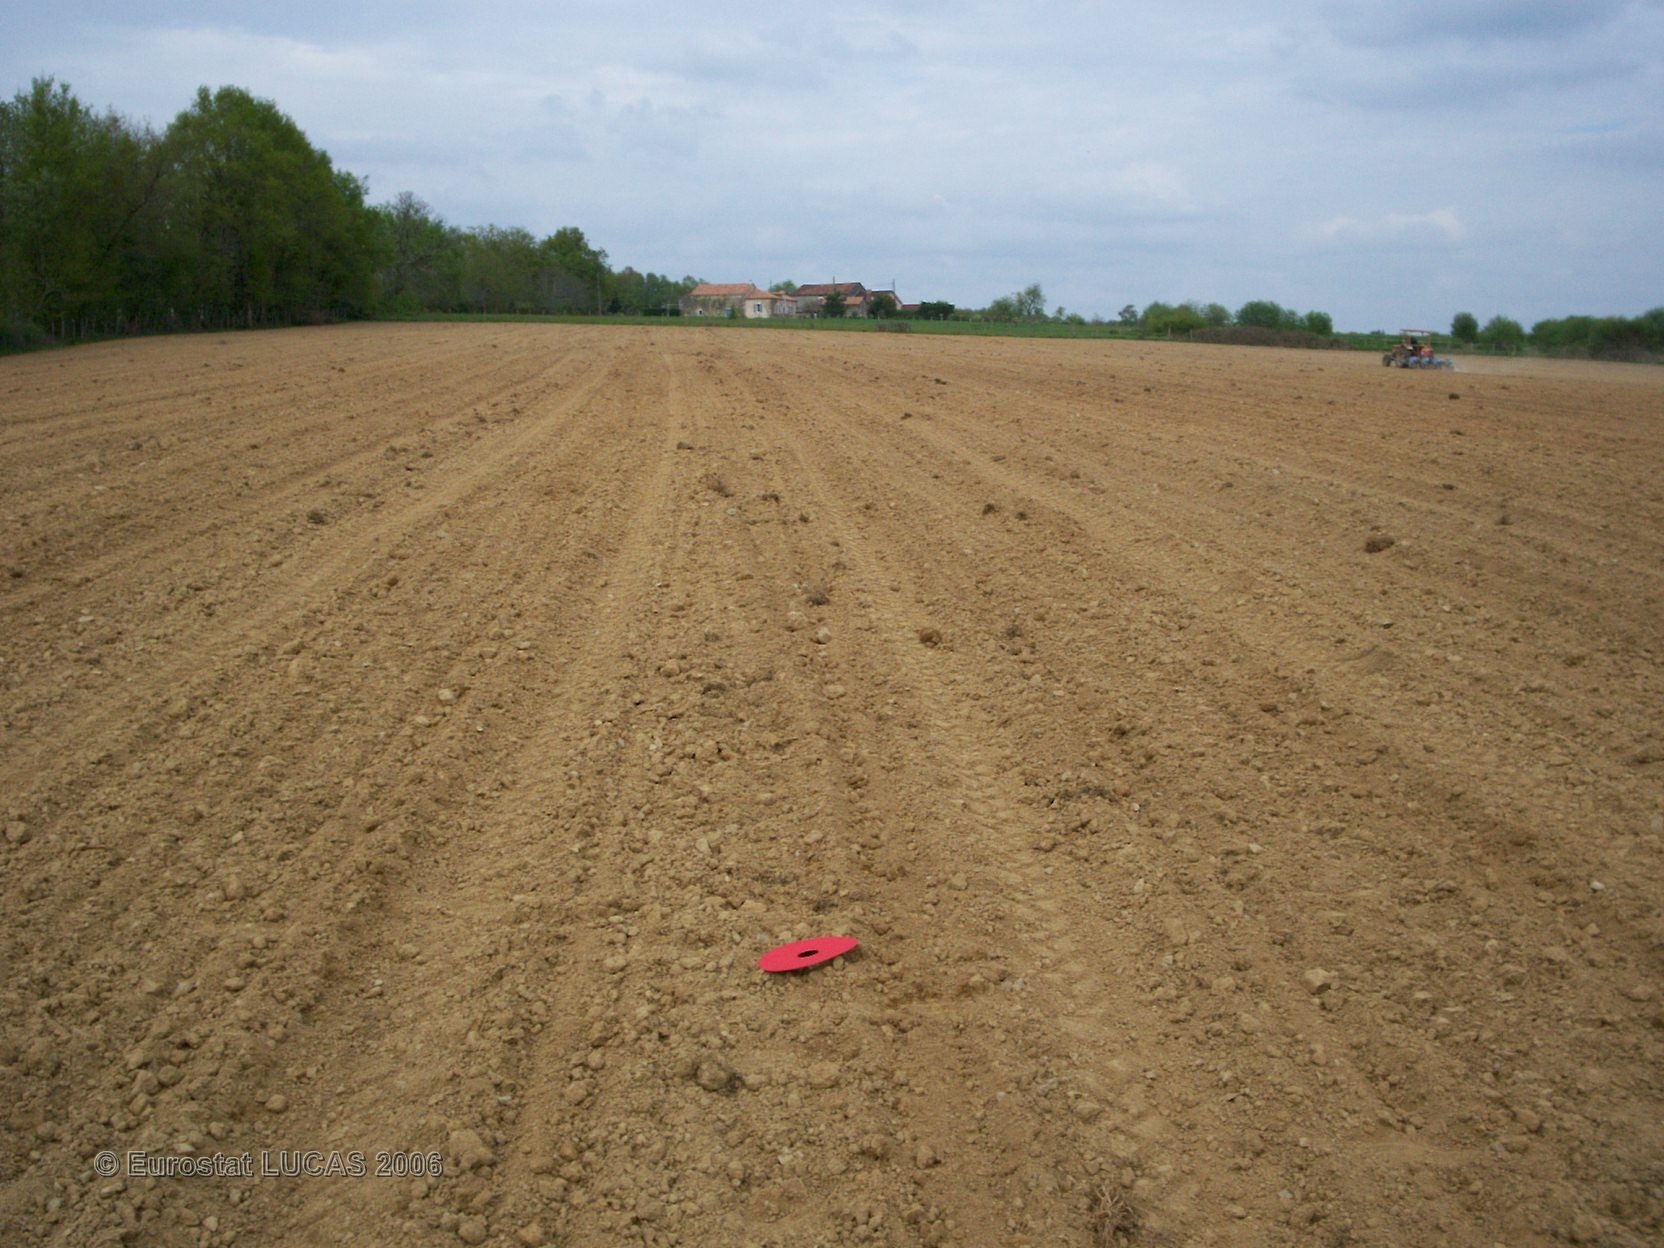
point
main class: Bare land
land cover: Bare land
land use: Agriculture (excluding fallow land and kitchen gardens)
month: April
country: FR
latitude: 45.4998
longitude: 0.7876
